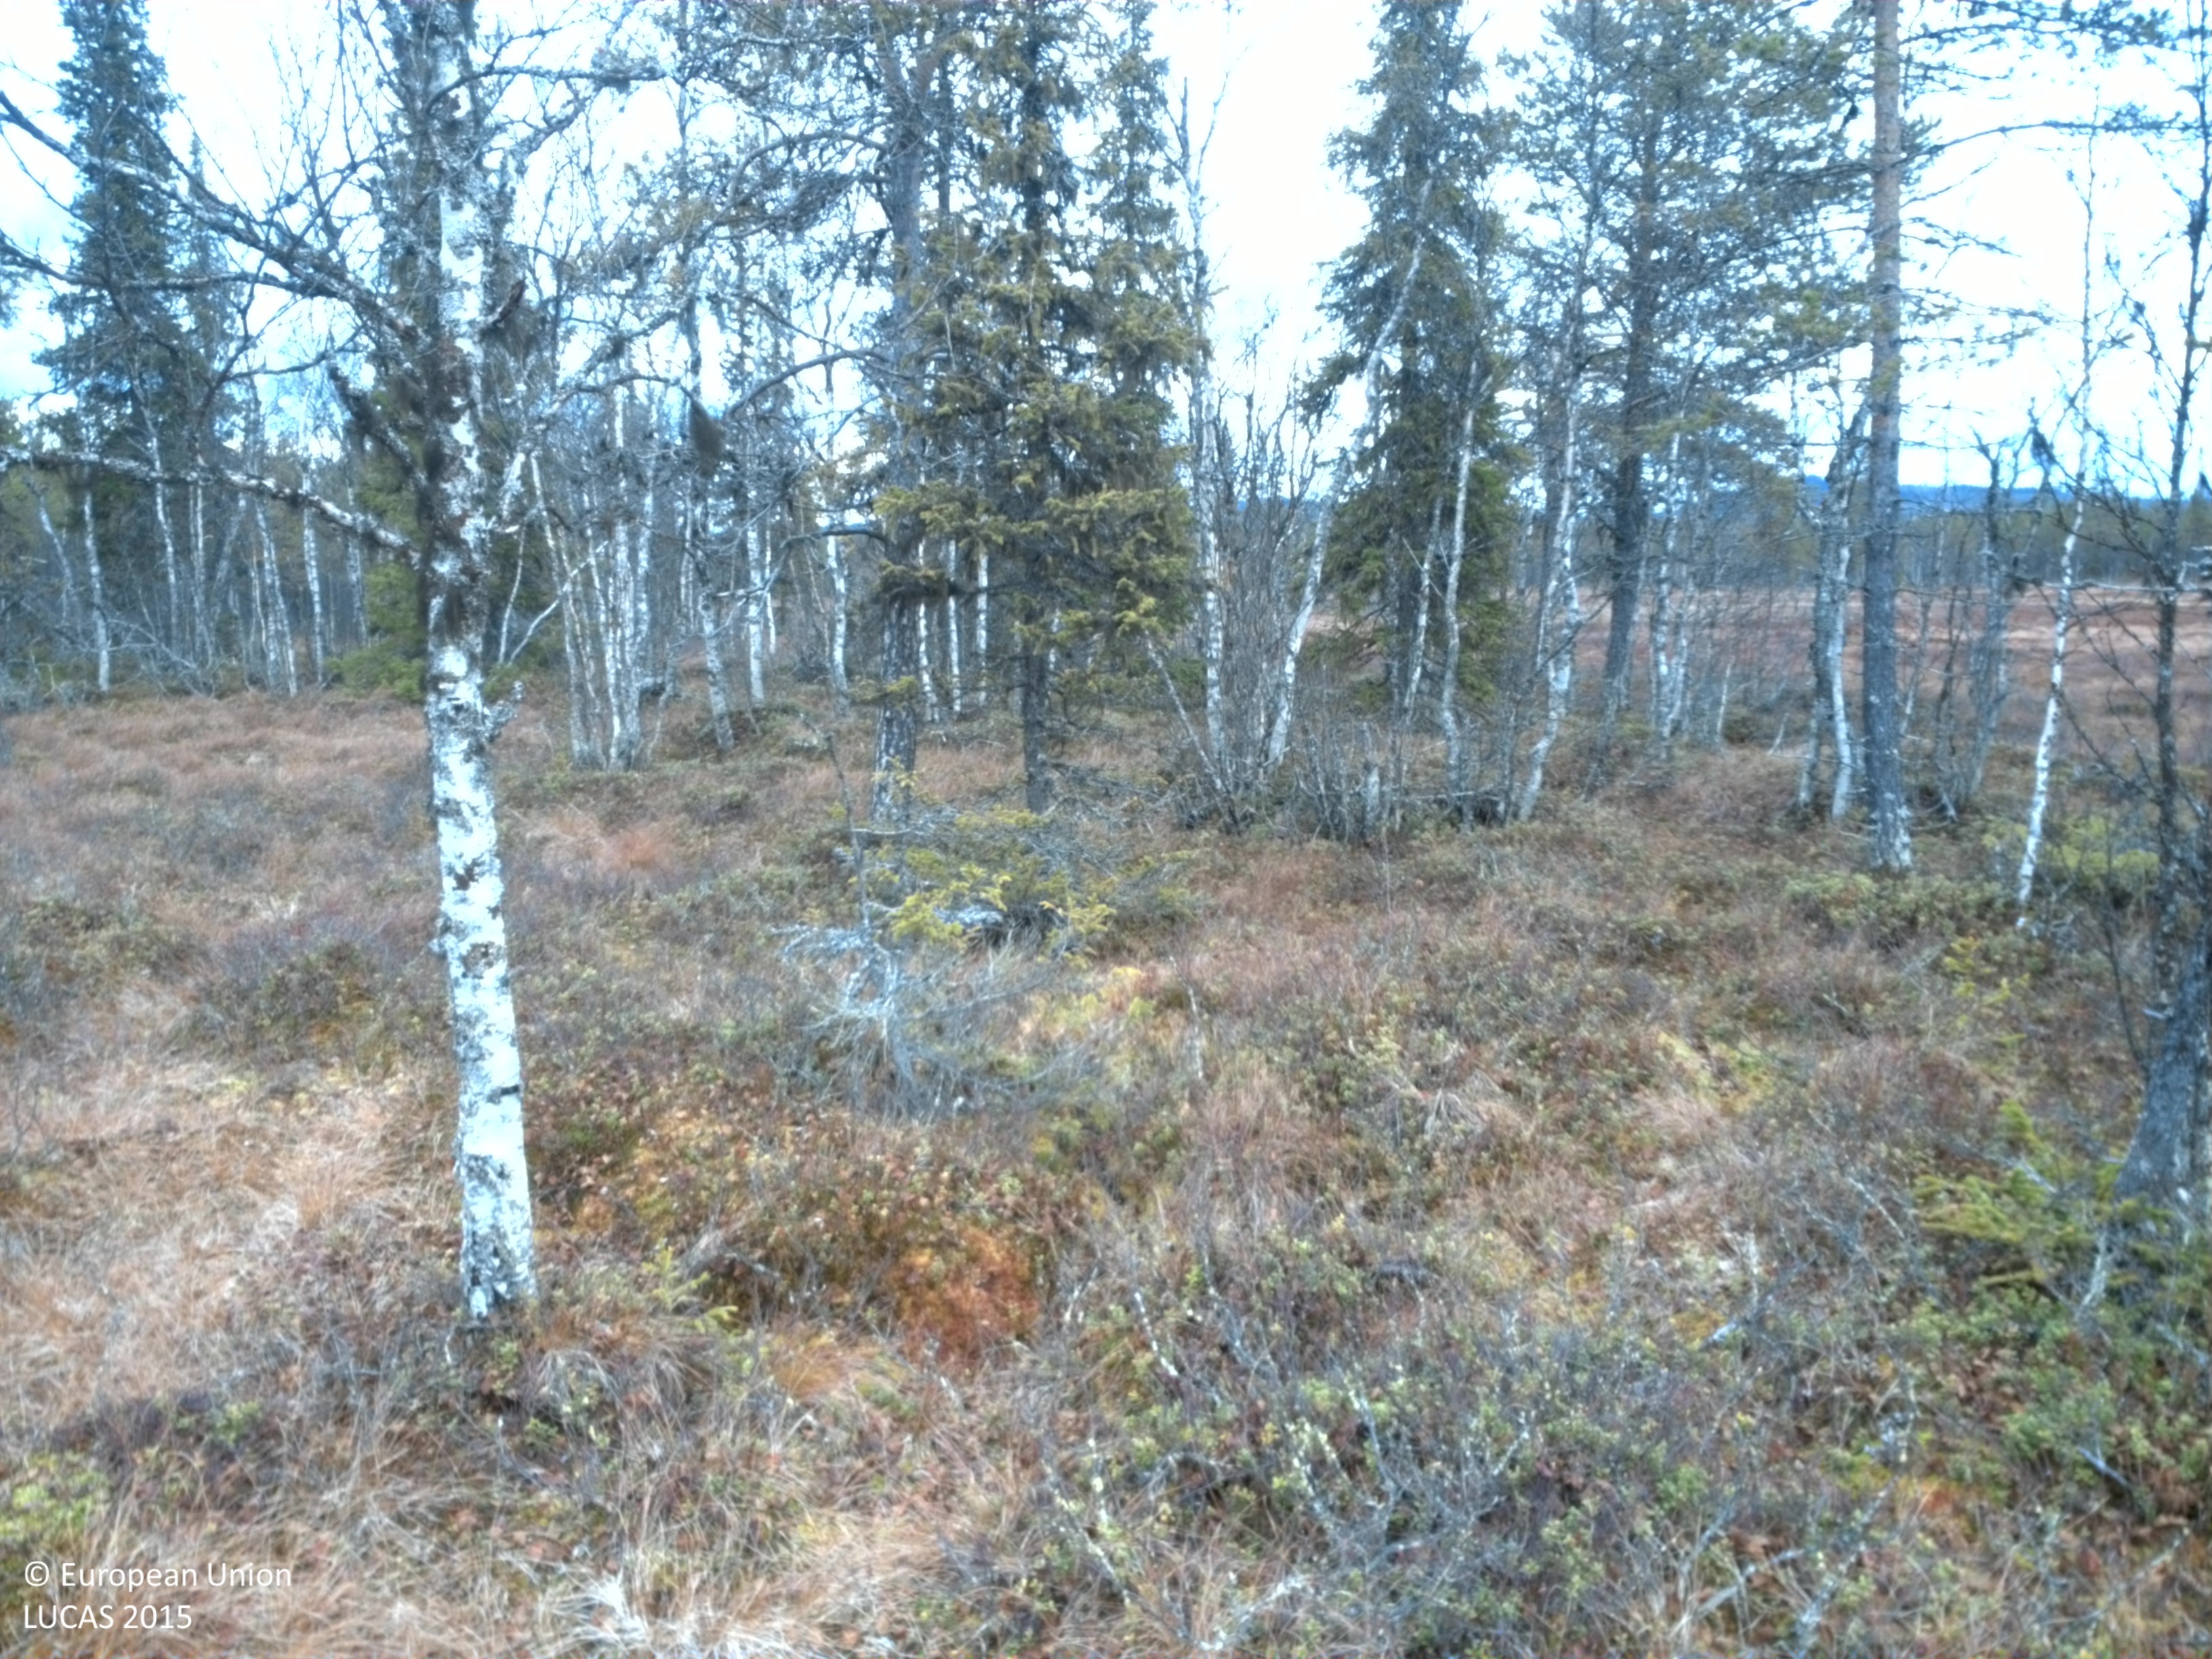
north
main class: Shrubland
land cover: Shrubland with sparse tree cover
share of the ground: 25 - 50 %
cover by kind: herbaceous plants 45 %, shrubs 25 %, lichens and mosses 25 %, coniferous forest trees 5 %
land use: Semi-natural and natural areas not in use
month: October
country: SE
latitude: 64.4760
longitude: 17.4762
